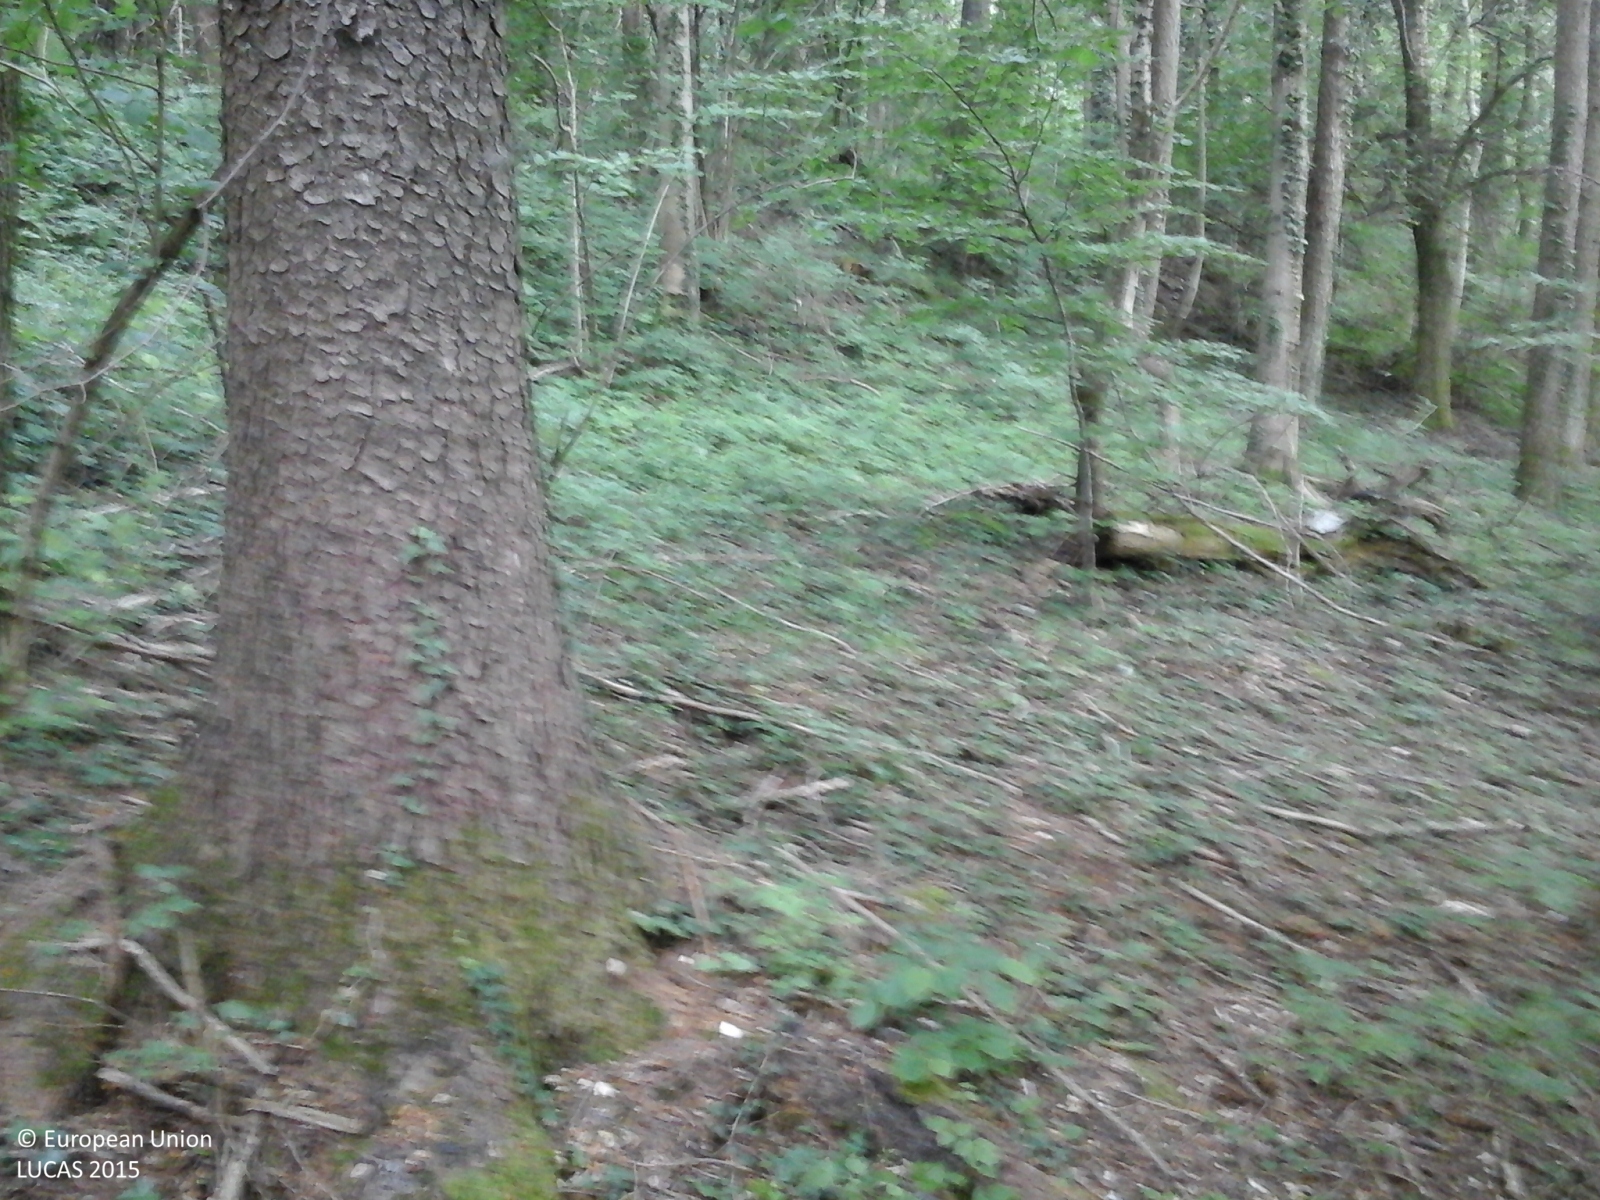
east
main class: Woodland
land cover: Spruce dominated mixed woodland
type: alpine coniferous forest
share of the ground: > 75 %
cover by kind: coniferous forest trees 75 %, broadleaved forest trees 25 %
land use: Forestry
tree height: > 5 m
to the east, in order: Spruce dominated mixed woodland; Tracks; Spruce dominated mixed woodland; Paved roads, cycling and walking lanes
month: June
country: IT
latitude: 45.6811
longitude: 10.8588
